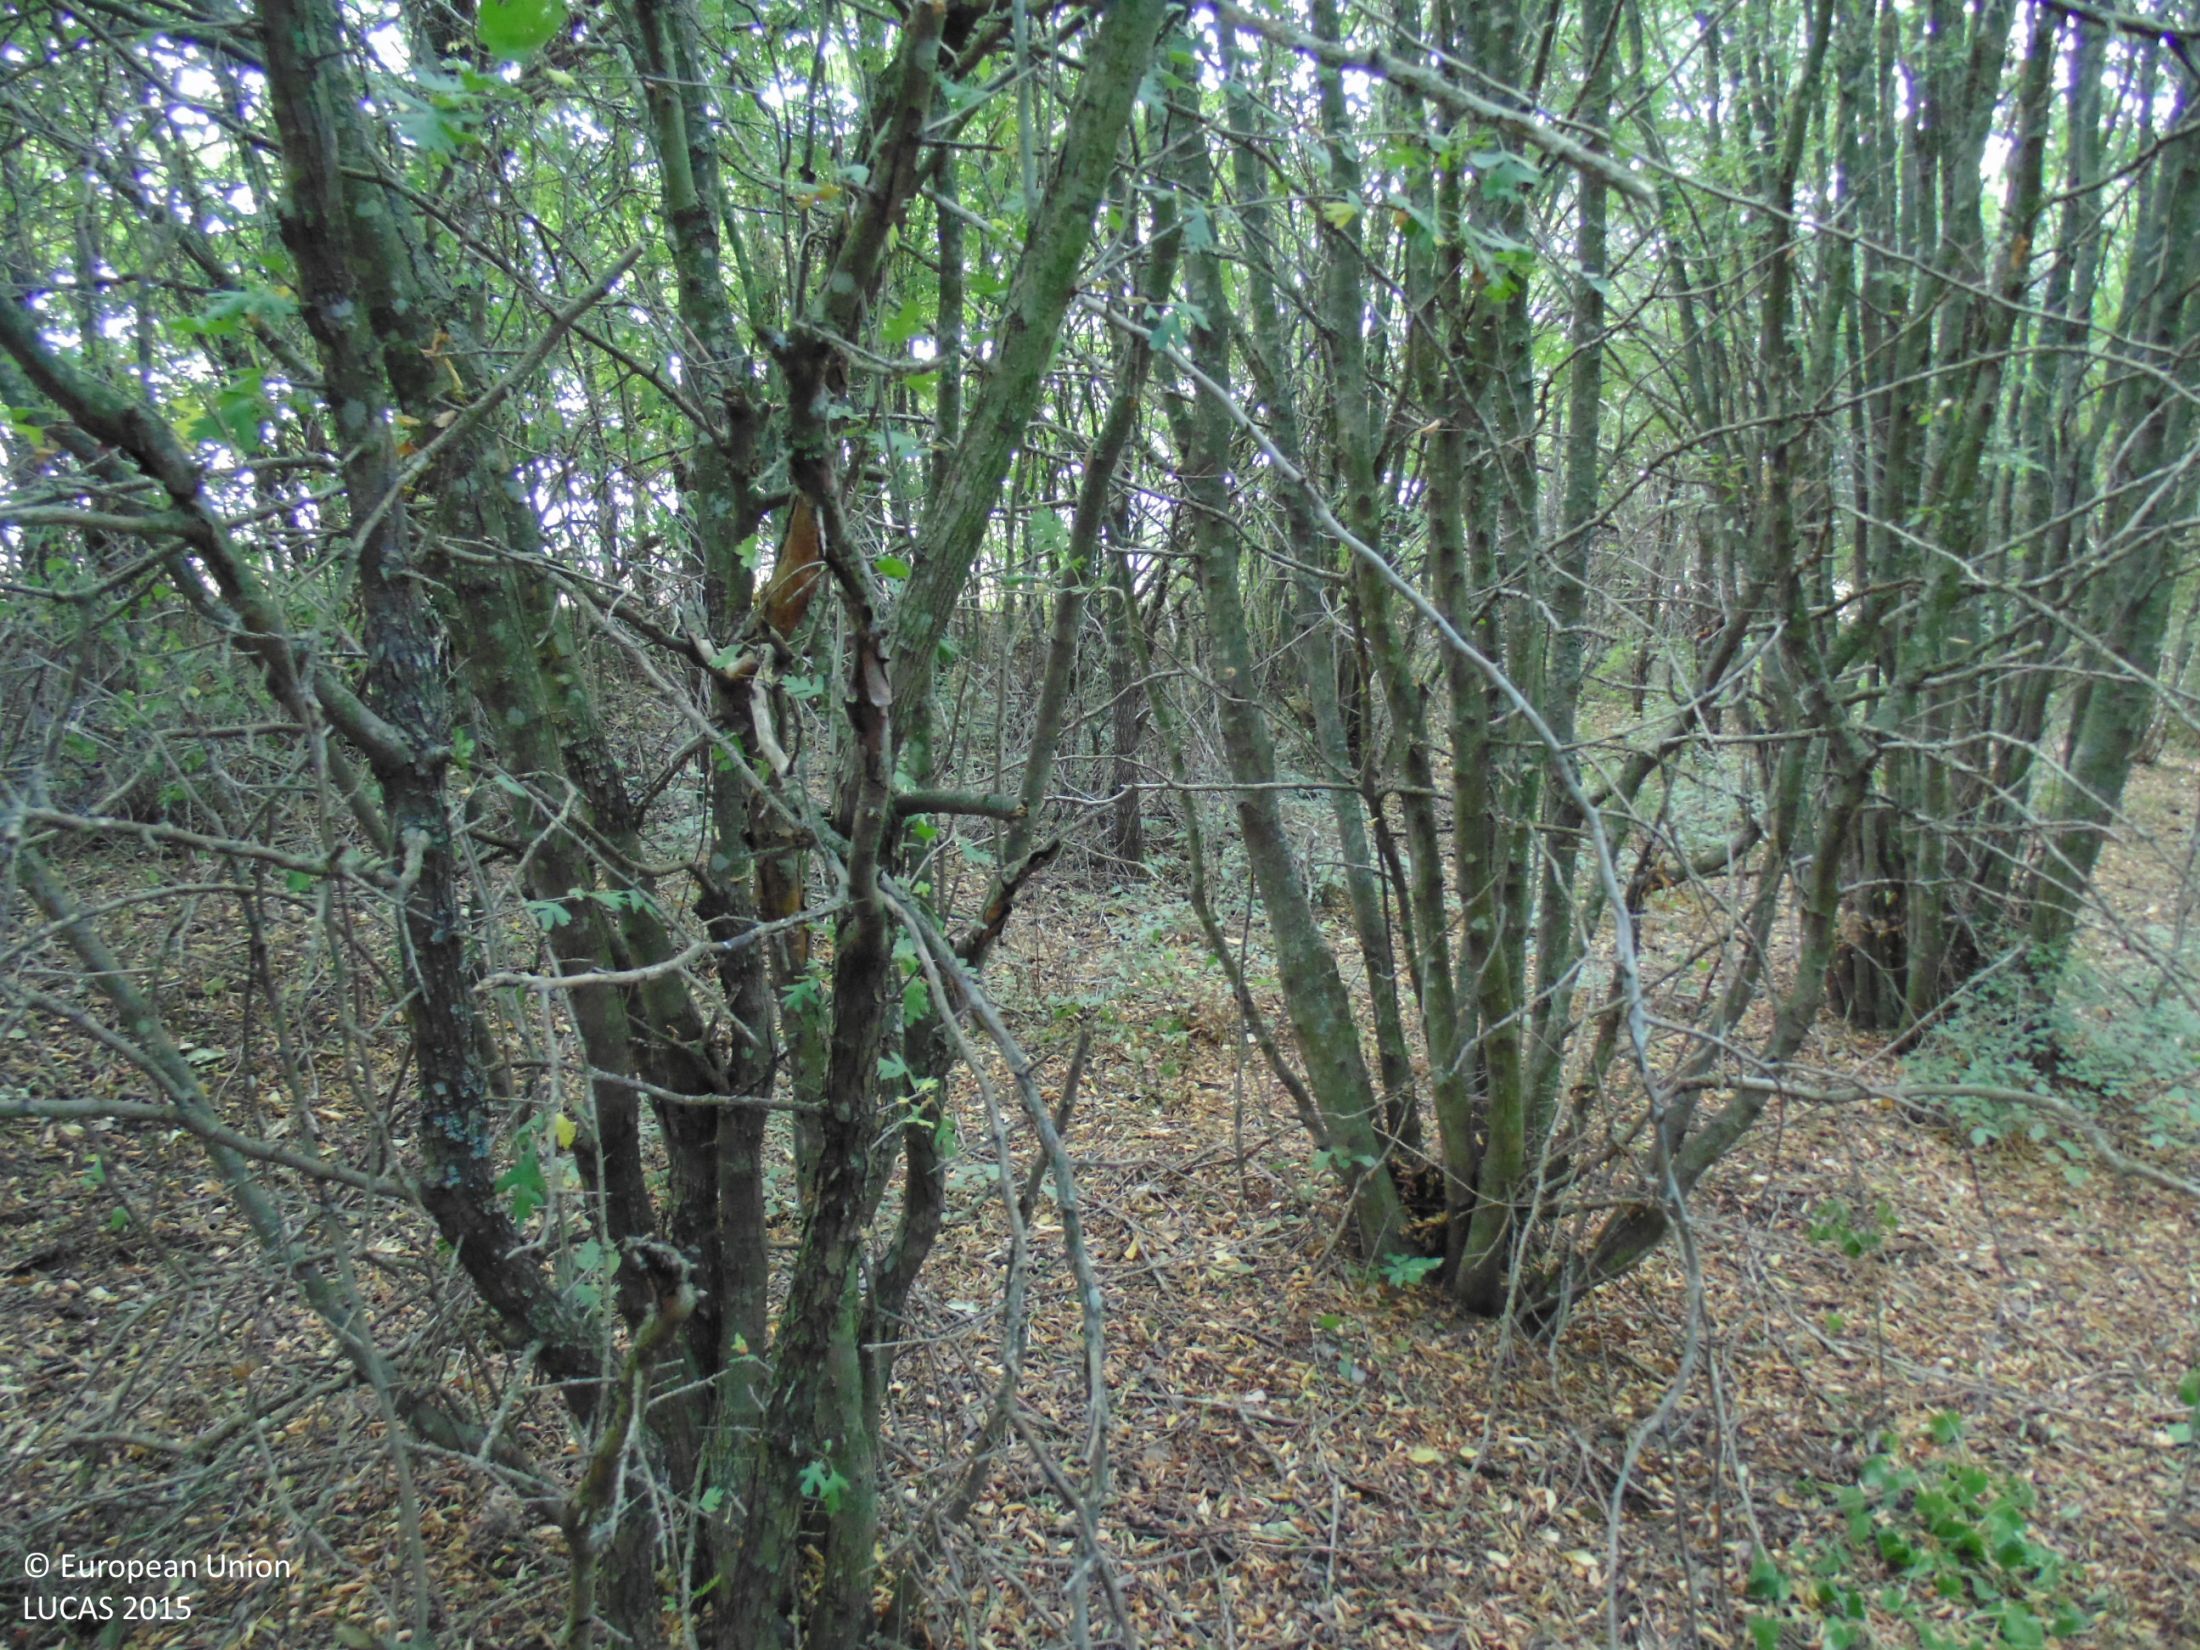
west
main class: Woodland
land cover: Broadleaved woodland
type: mesophytic deciduous forest
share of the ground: > 75 %
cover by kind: broadleaved forest trees 95 %, unconsolidated bare surface 5 %
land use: Forestry
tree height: > 5 m
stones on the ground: < 10 %
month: August
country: BG
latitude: 43.9127
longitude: 27.6359
